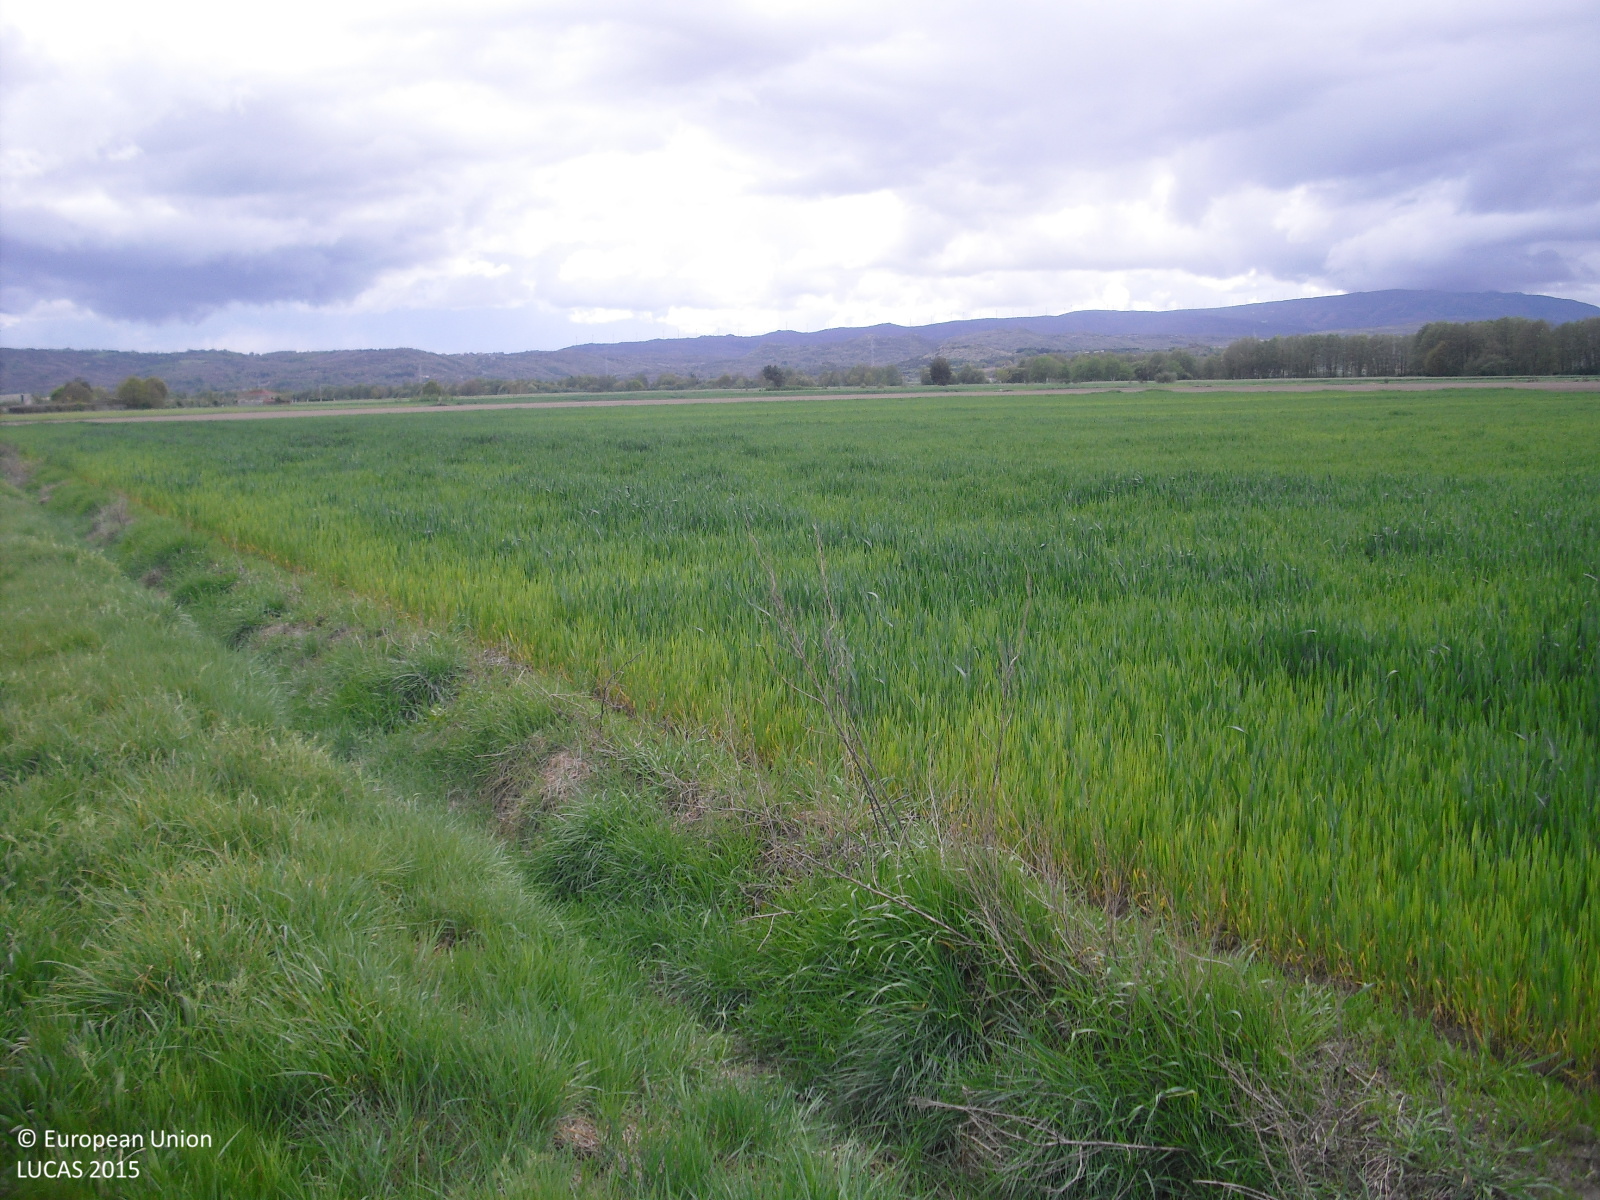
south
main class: Artificial land
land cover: Non built-up linear features
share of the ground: > 75 %
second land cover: Spontaneously vegetated surfaces
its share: 25 - 50 %
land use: Road transport
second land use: Agriculture (excluding fallow land and kitchen gardens)
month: April
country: ES
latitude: 42.0449
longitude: -7.6701
